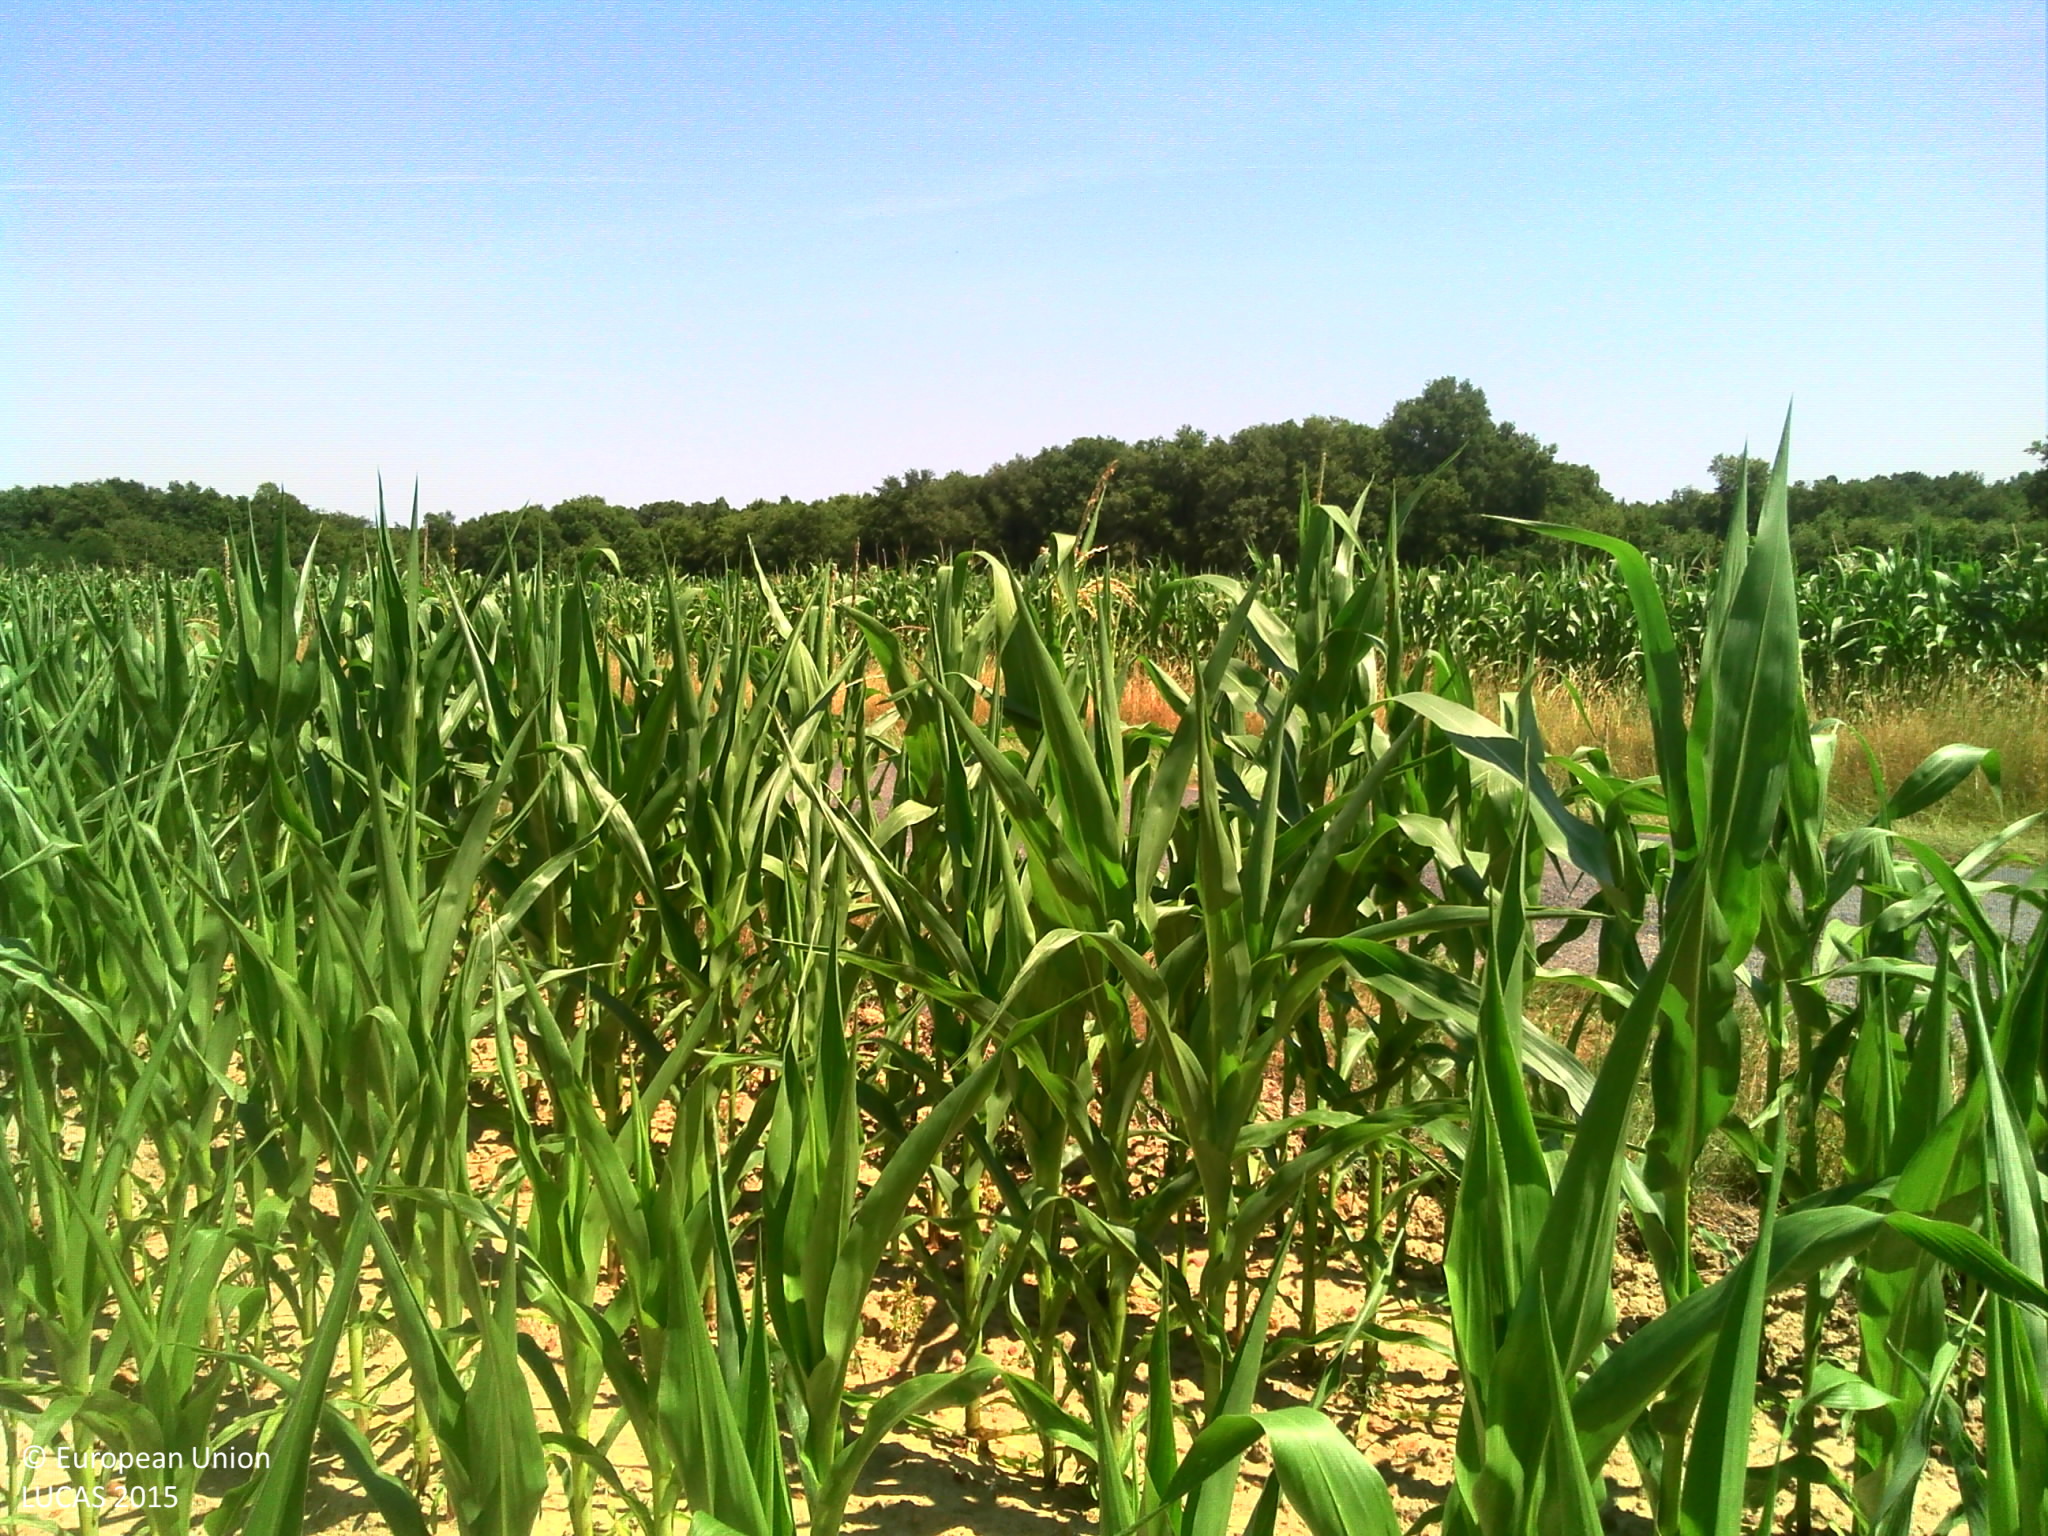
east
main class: Cropland
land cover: Maize
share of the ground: 25 - 50 %
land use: Agriculture (excluding fallow land and kitchen gardens)
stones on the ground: 10 - 25 %
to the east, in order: Maize; Grass margins; Ditches and canals; Grass margins; Paved roads, cycling and walking lanes; Grass margins; Ditches and canals; Grass margins; Maize; Grass margins; Tracks; Grass margins; Broadleaved woodland
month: July
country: FR
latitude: 47.2182
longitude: 0.7515
